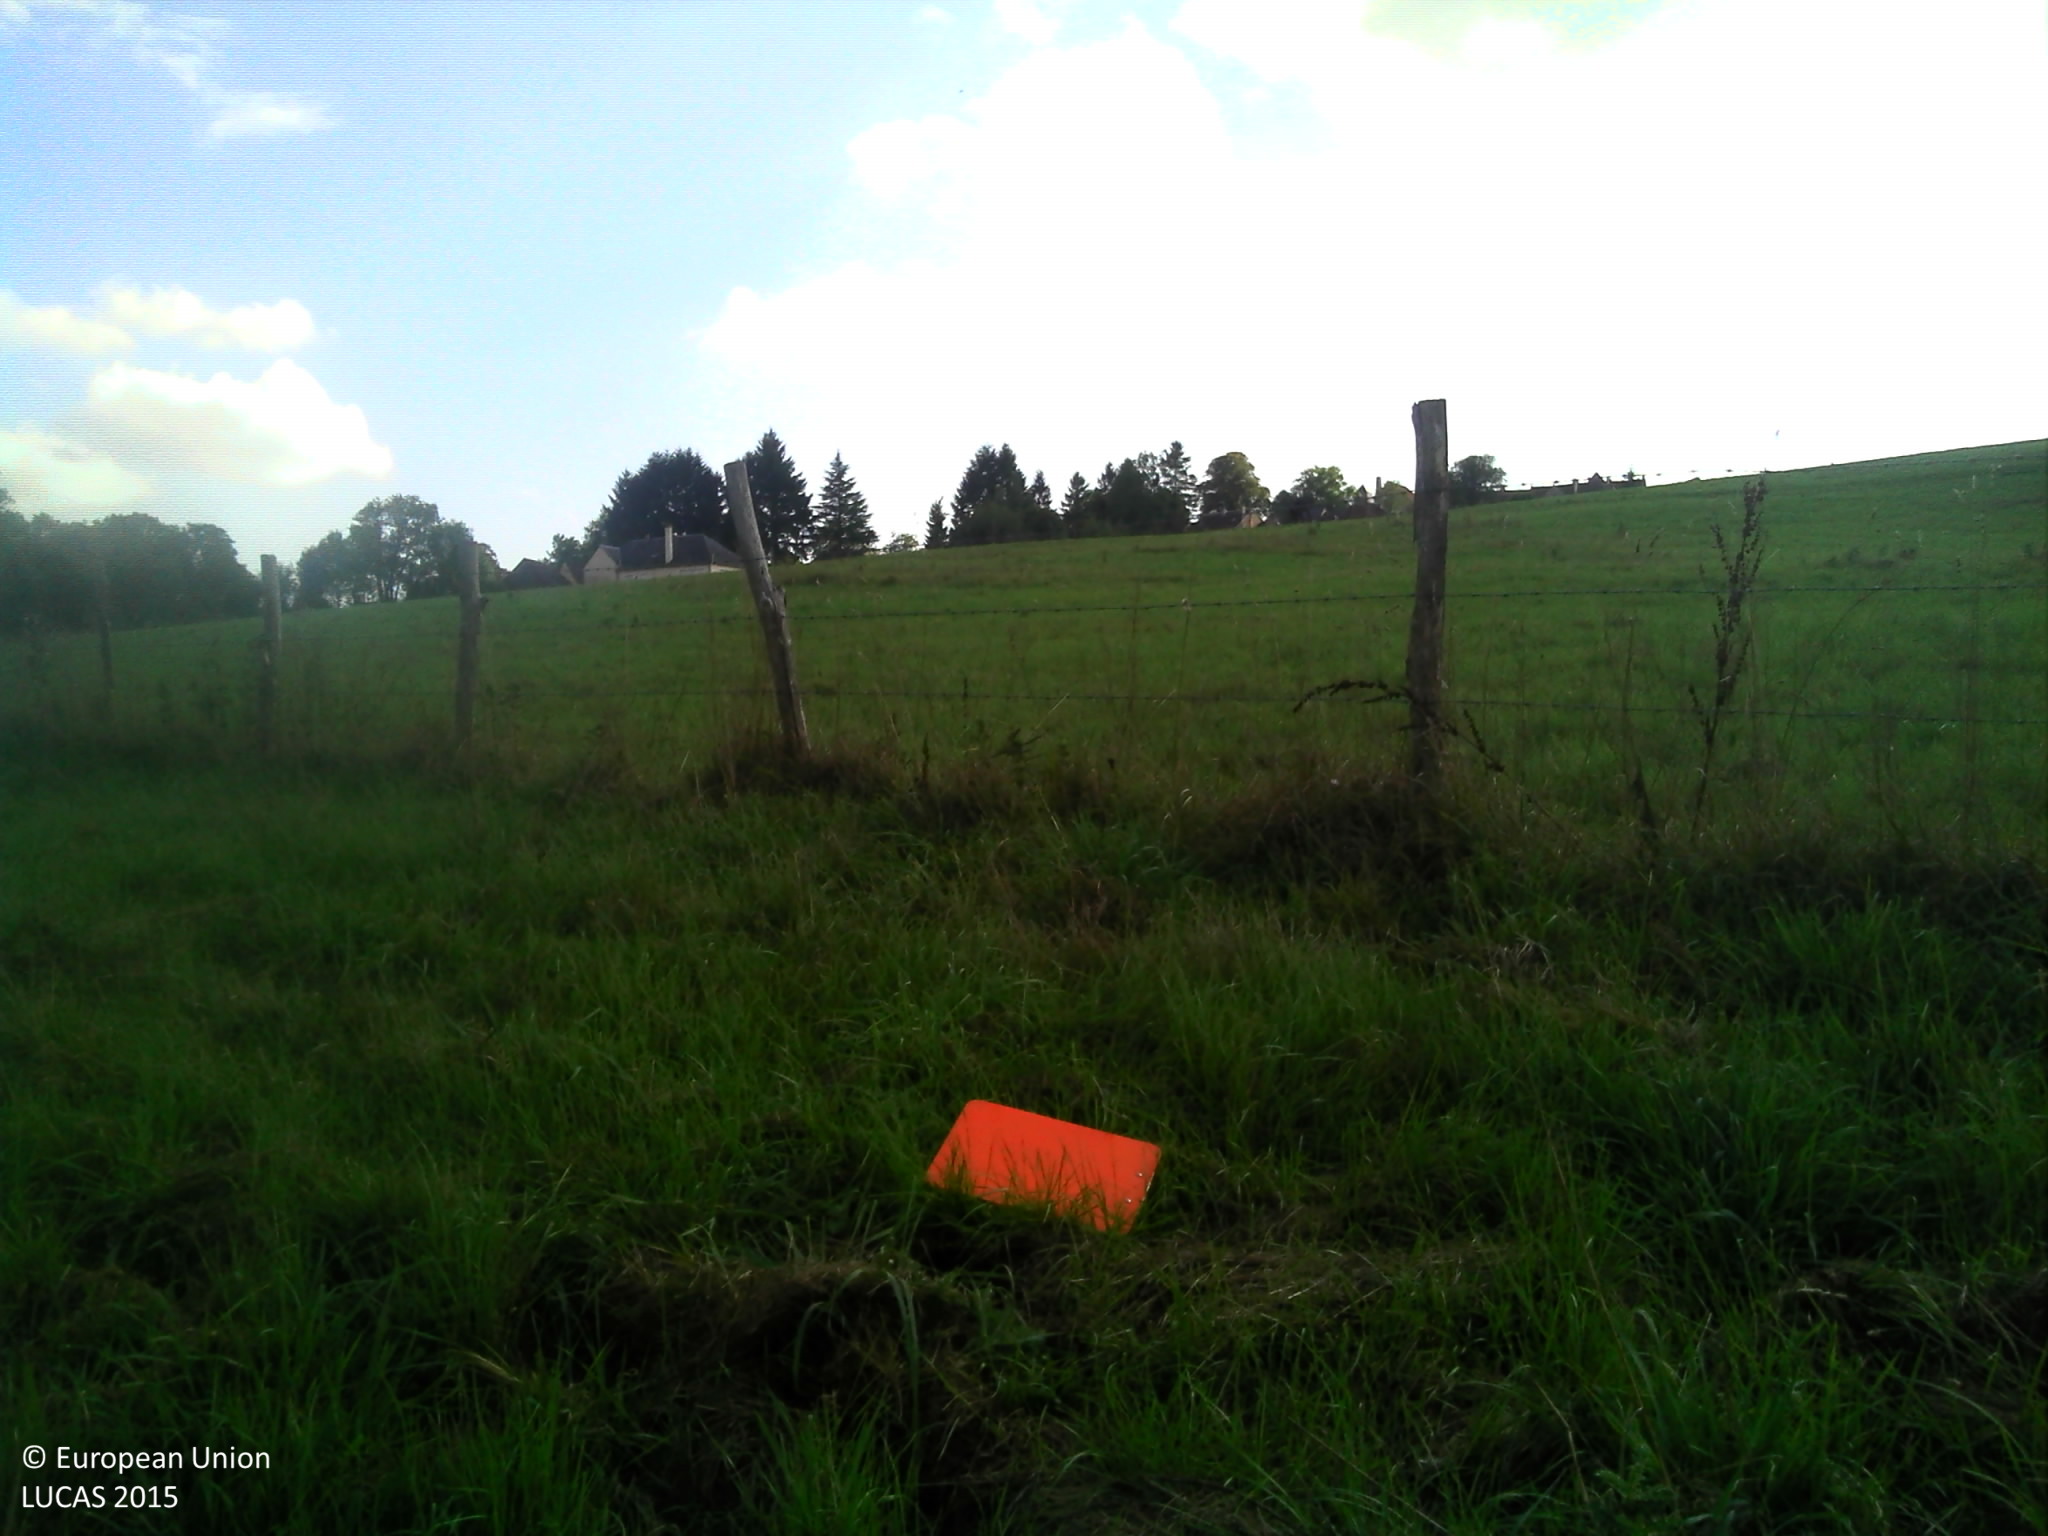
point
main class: Grassland
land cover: Grassland without tree/shrub cover
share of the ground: > 75 %
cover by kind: herbaceous plants 100 %
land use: Agriculture (excluding fallow land and kitchen gardens)
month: September
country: FR
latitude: 48.3797
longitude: 0.5653
